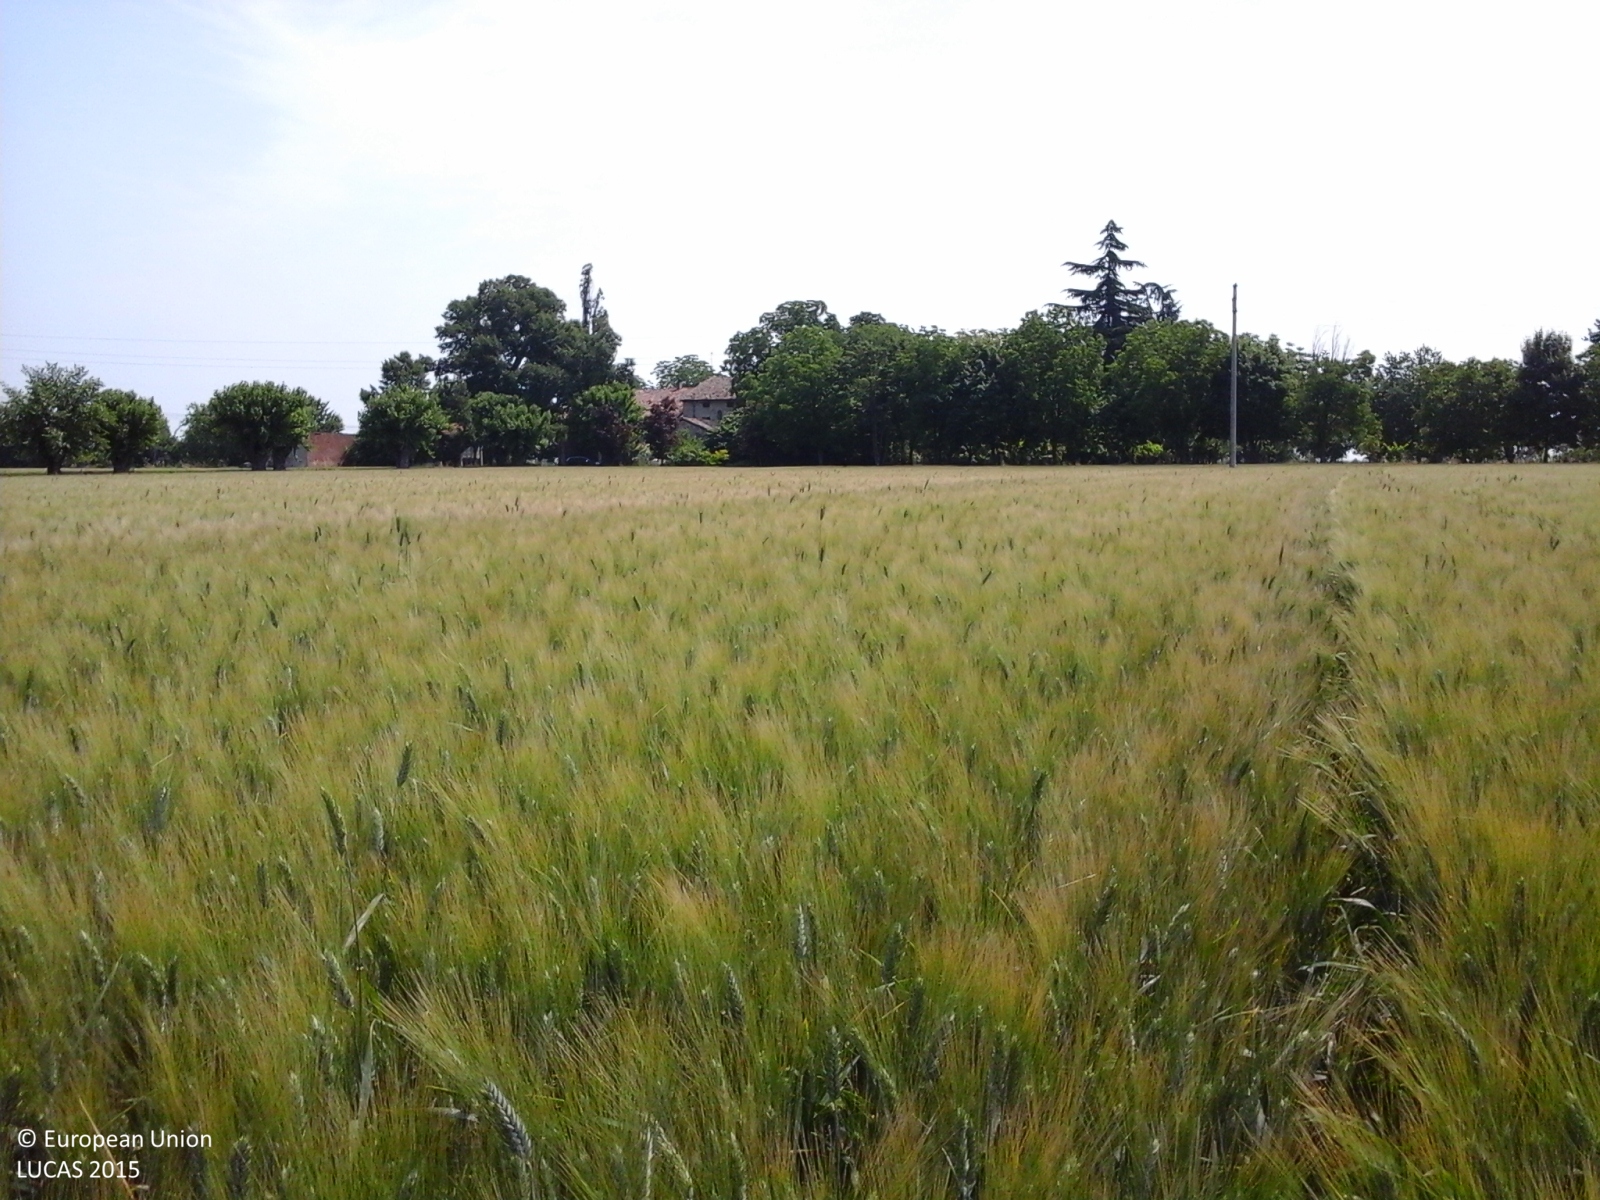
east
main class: Cropland
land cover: Common wheat
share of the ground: > 75 %
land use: Agriculture (excluding fallow land and kitchen gardens)
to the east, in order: Common wheat; Electric lines; Common wheat; Tracks; Broadleaved woodland; Artificial constructions in urban areas; Broadleaved woodland; Lucerne; Grass margins; Tracks
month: May
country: IT
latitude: 44.7831
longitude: 10.2144
